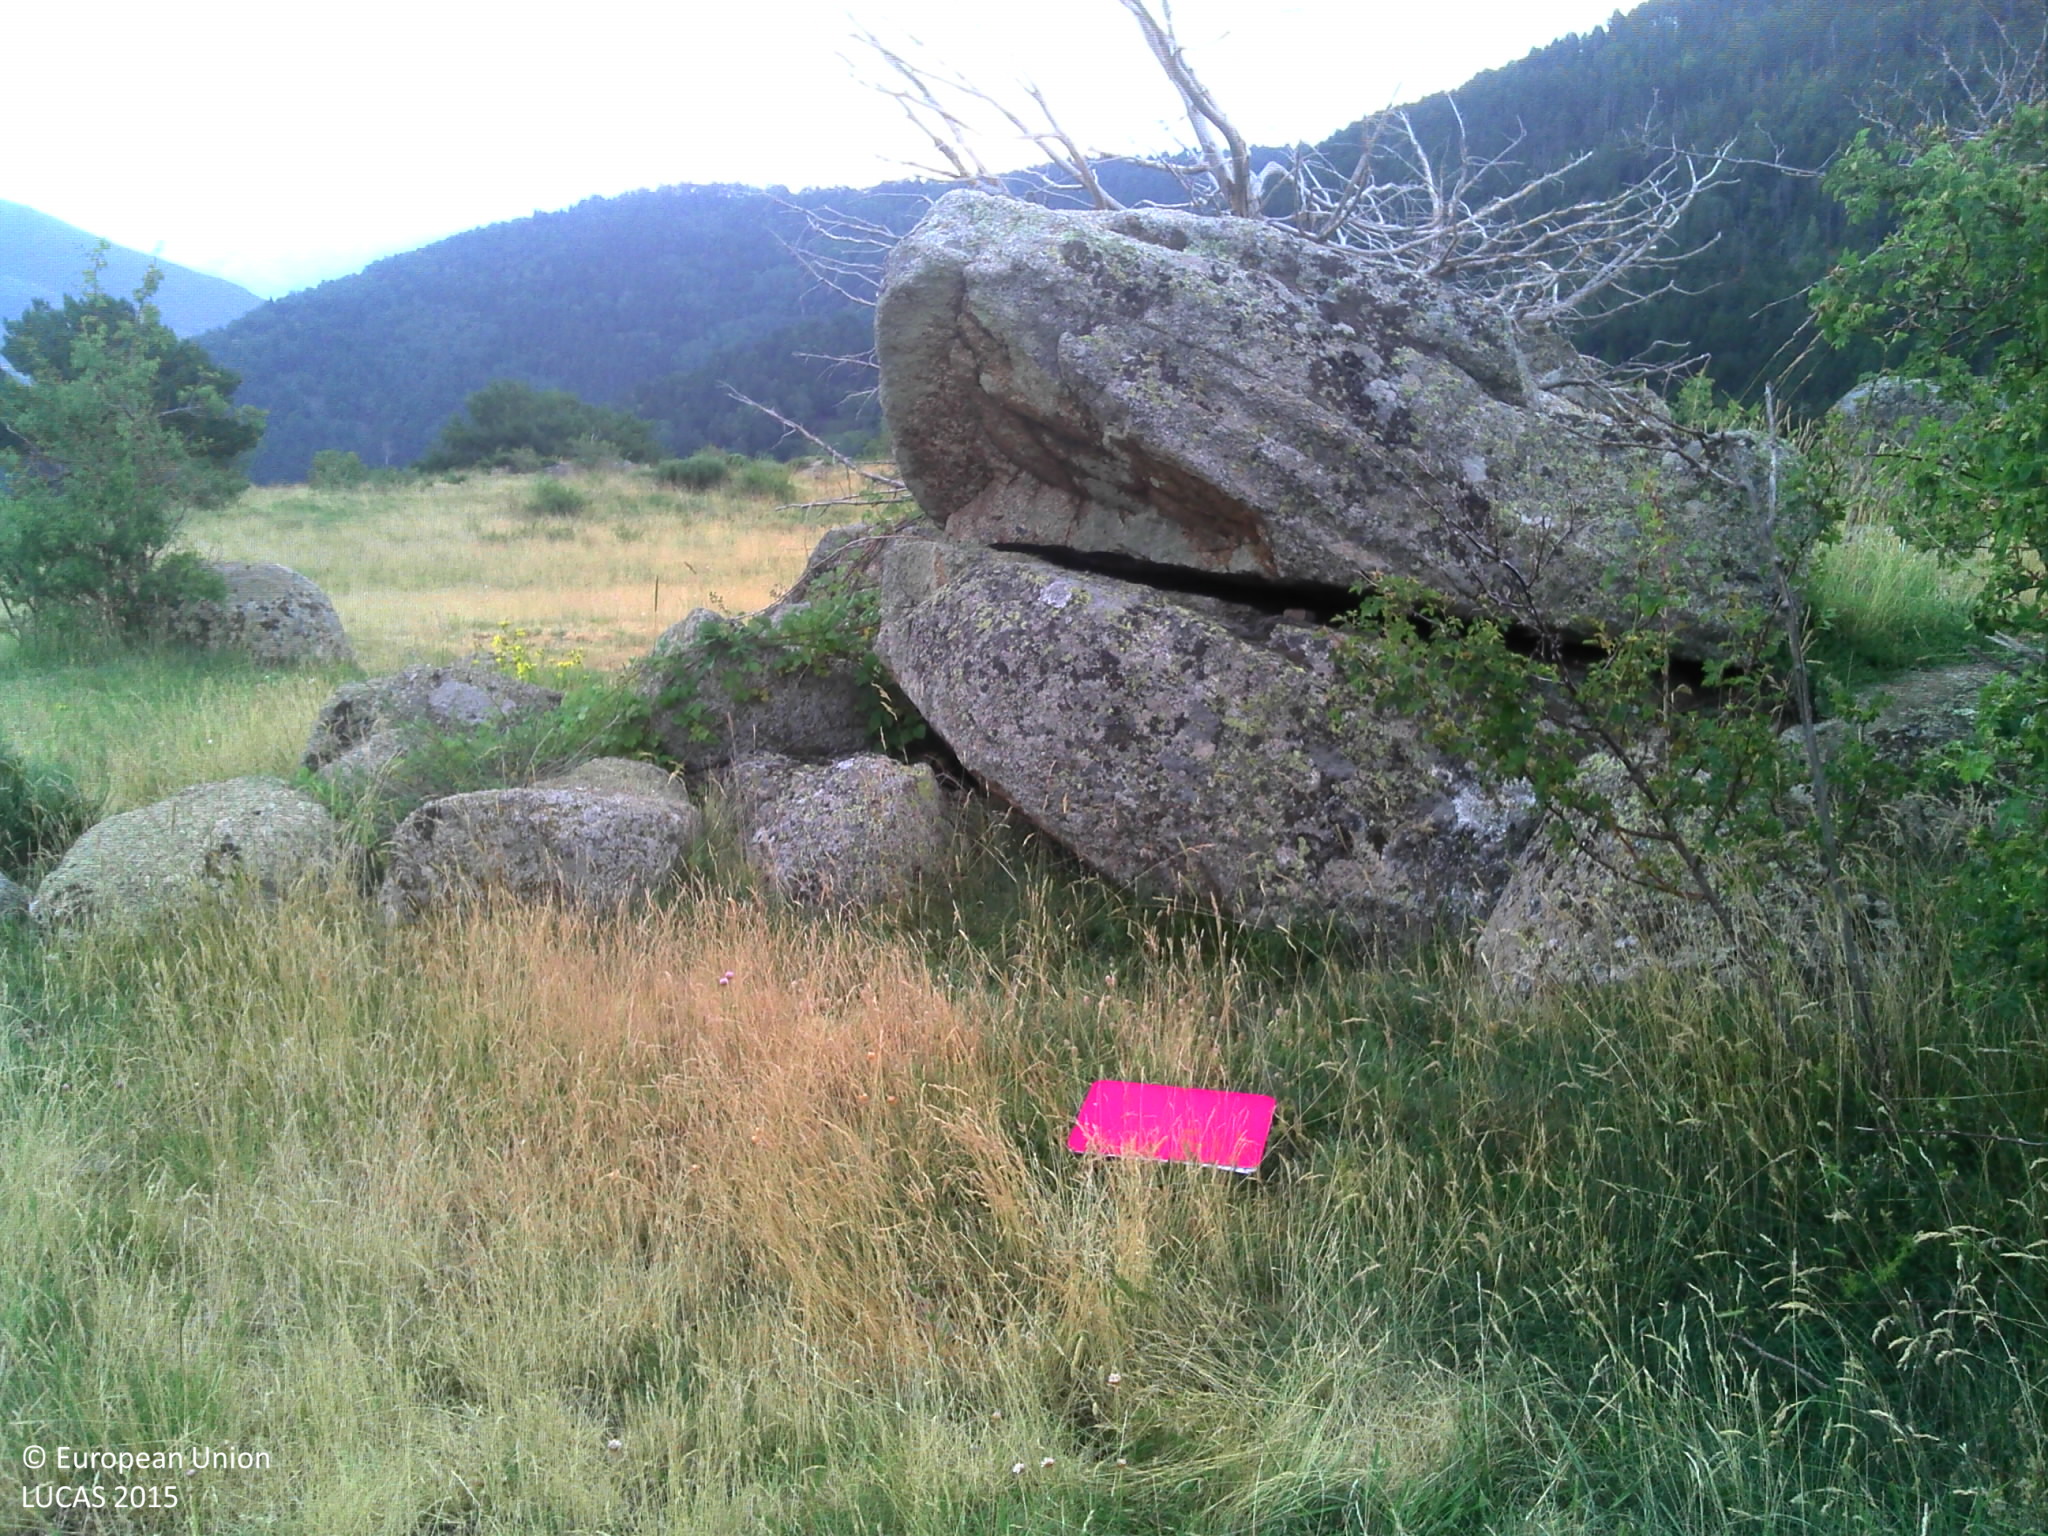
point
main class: Shrubland
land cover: Shrubland without tree cover
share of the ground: > 75 %
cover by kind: herbaceous plants 70 %, shrubs 20 %, consolidated bare surface 10 %
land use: Agriculture (excluding fallow land and kitchen gardens)
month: July
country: FR
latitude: 42.5868
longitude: 2.1757
